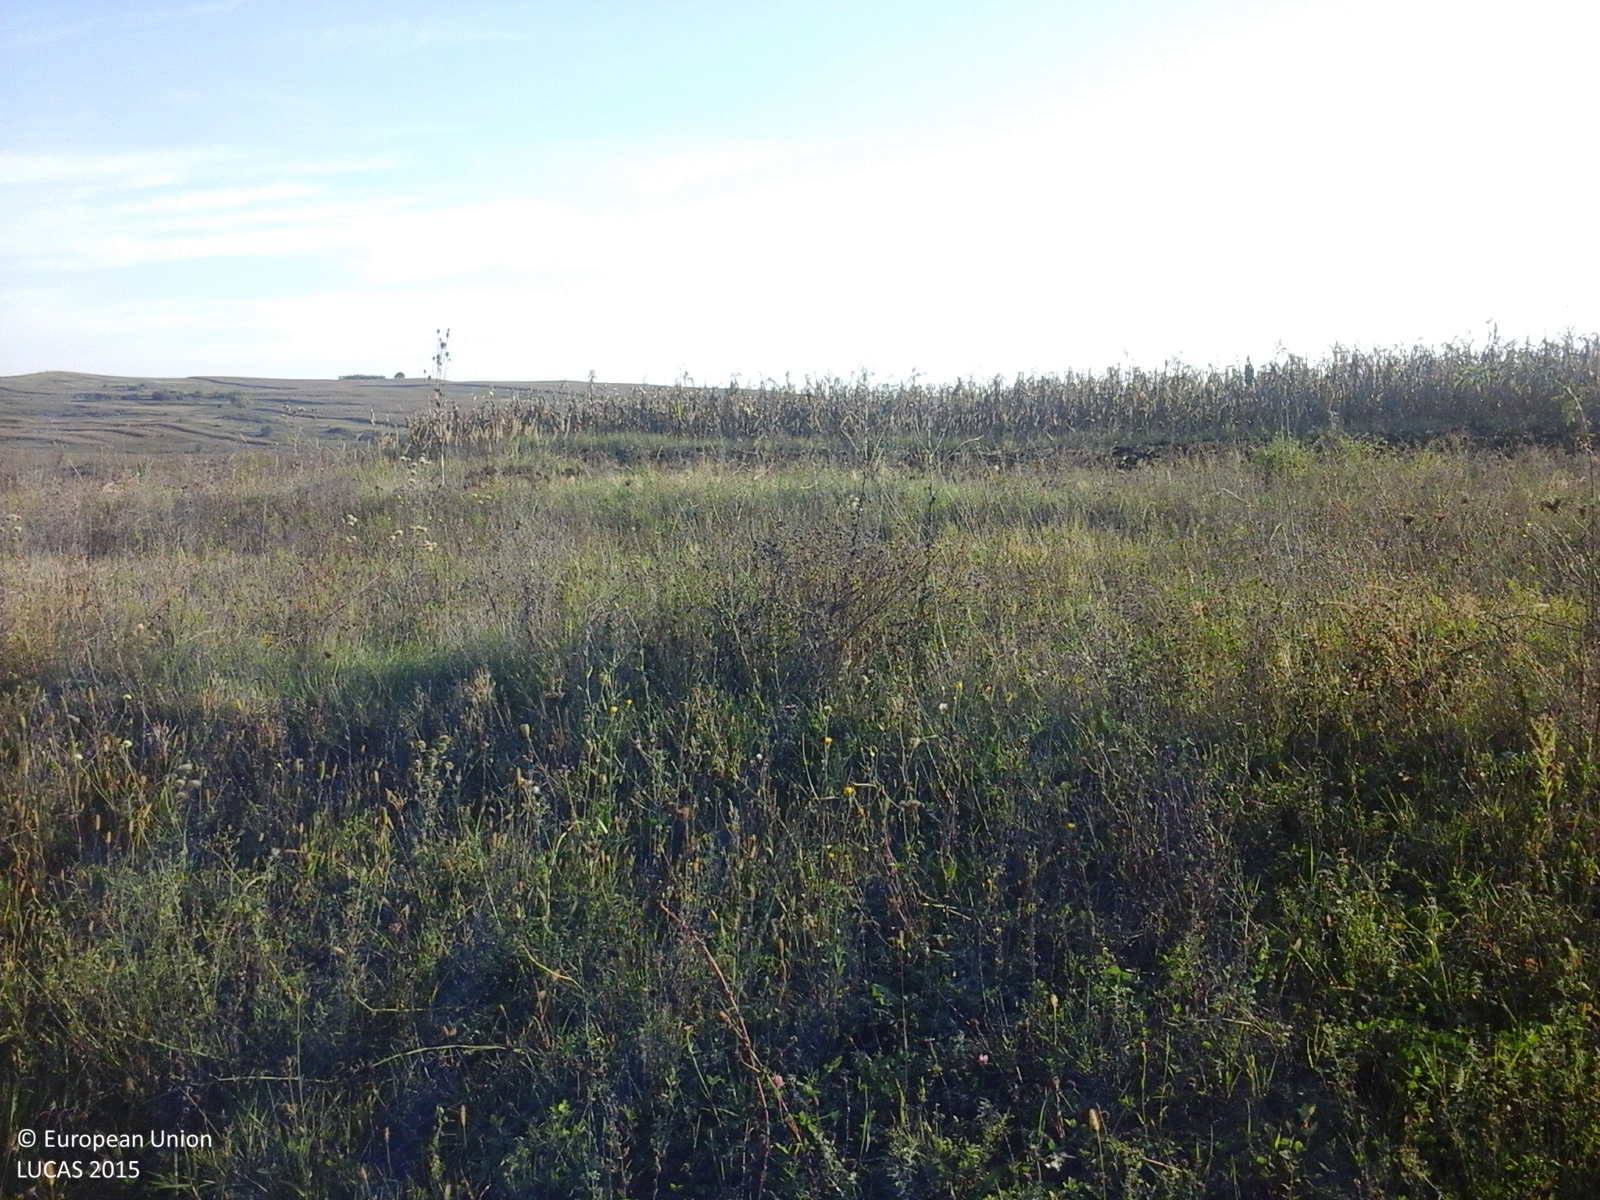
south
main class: Grassland
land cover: Spontaneously vegetated surfaces
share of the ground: > 75 %
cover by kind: herbaceous plants 100 %
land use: Agriculture (excluding fallow land and kitchen gardens)
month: October
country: RO
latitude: 46.2329
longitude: 23.8298
